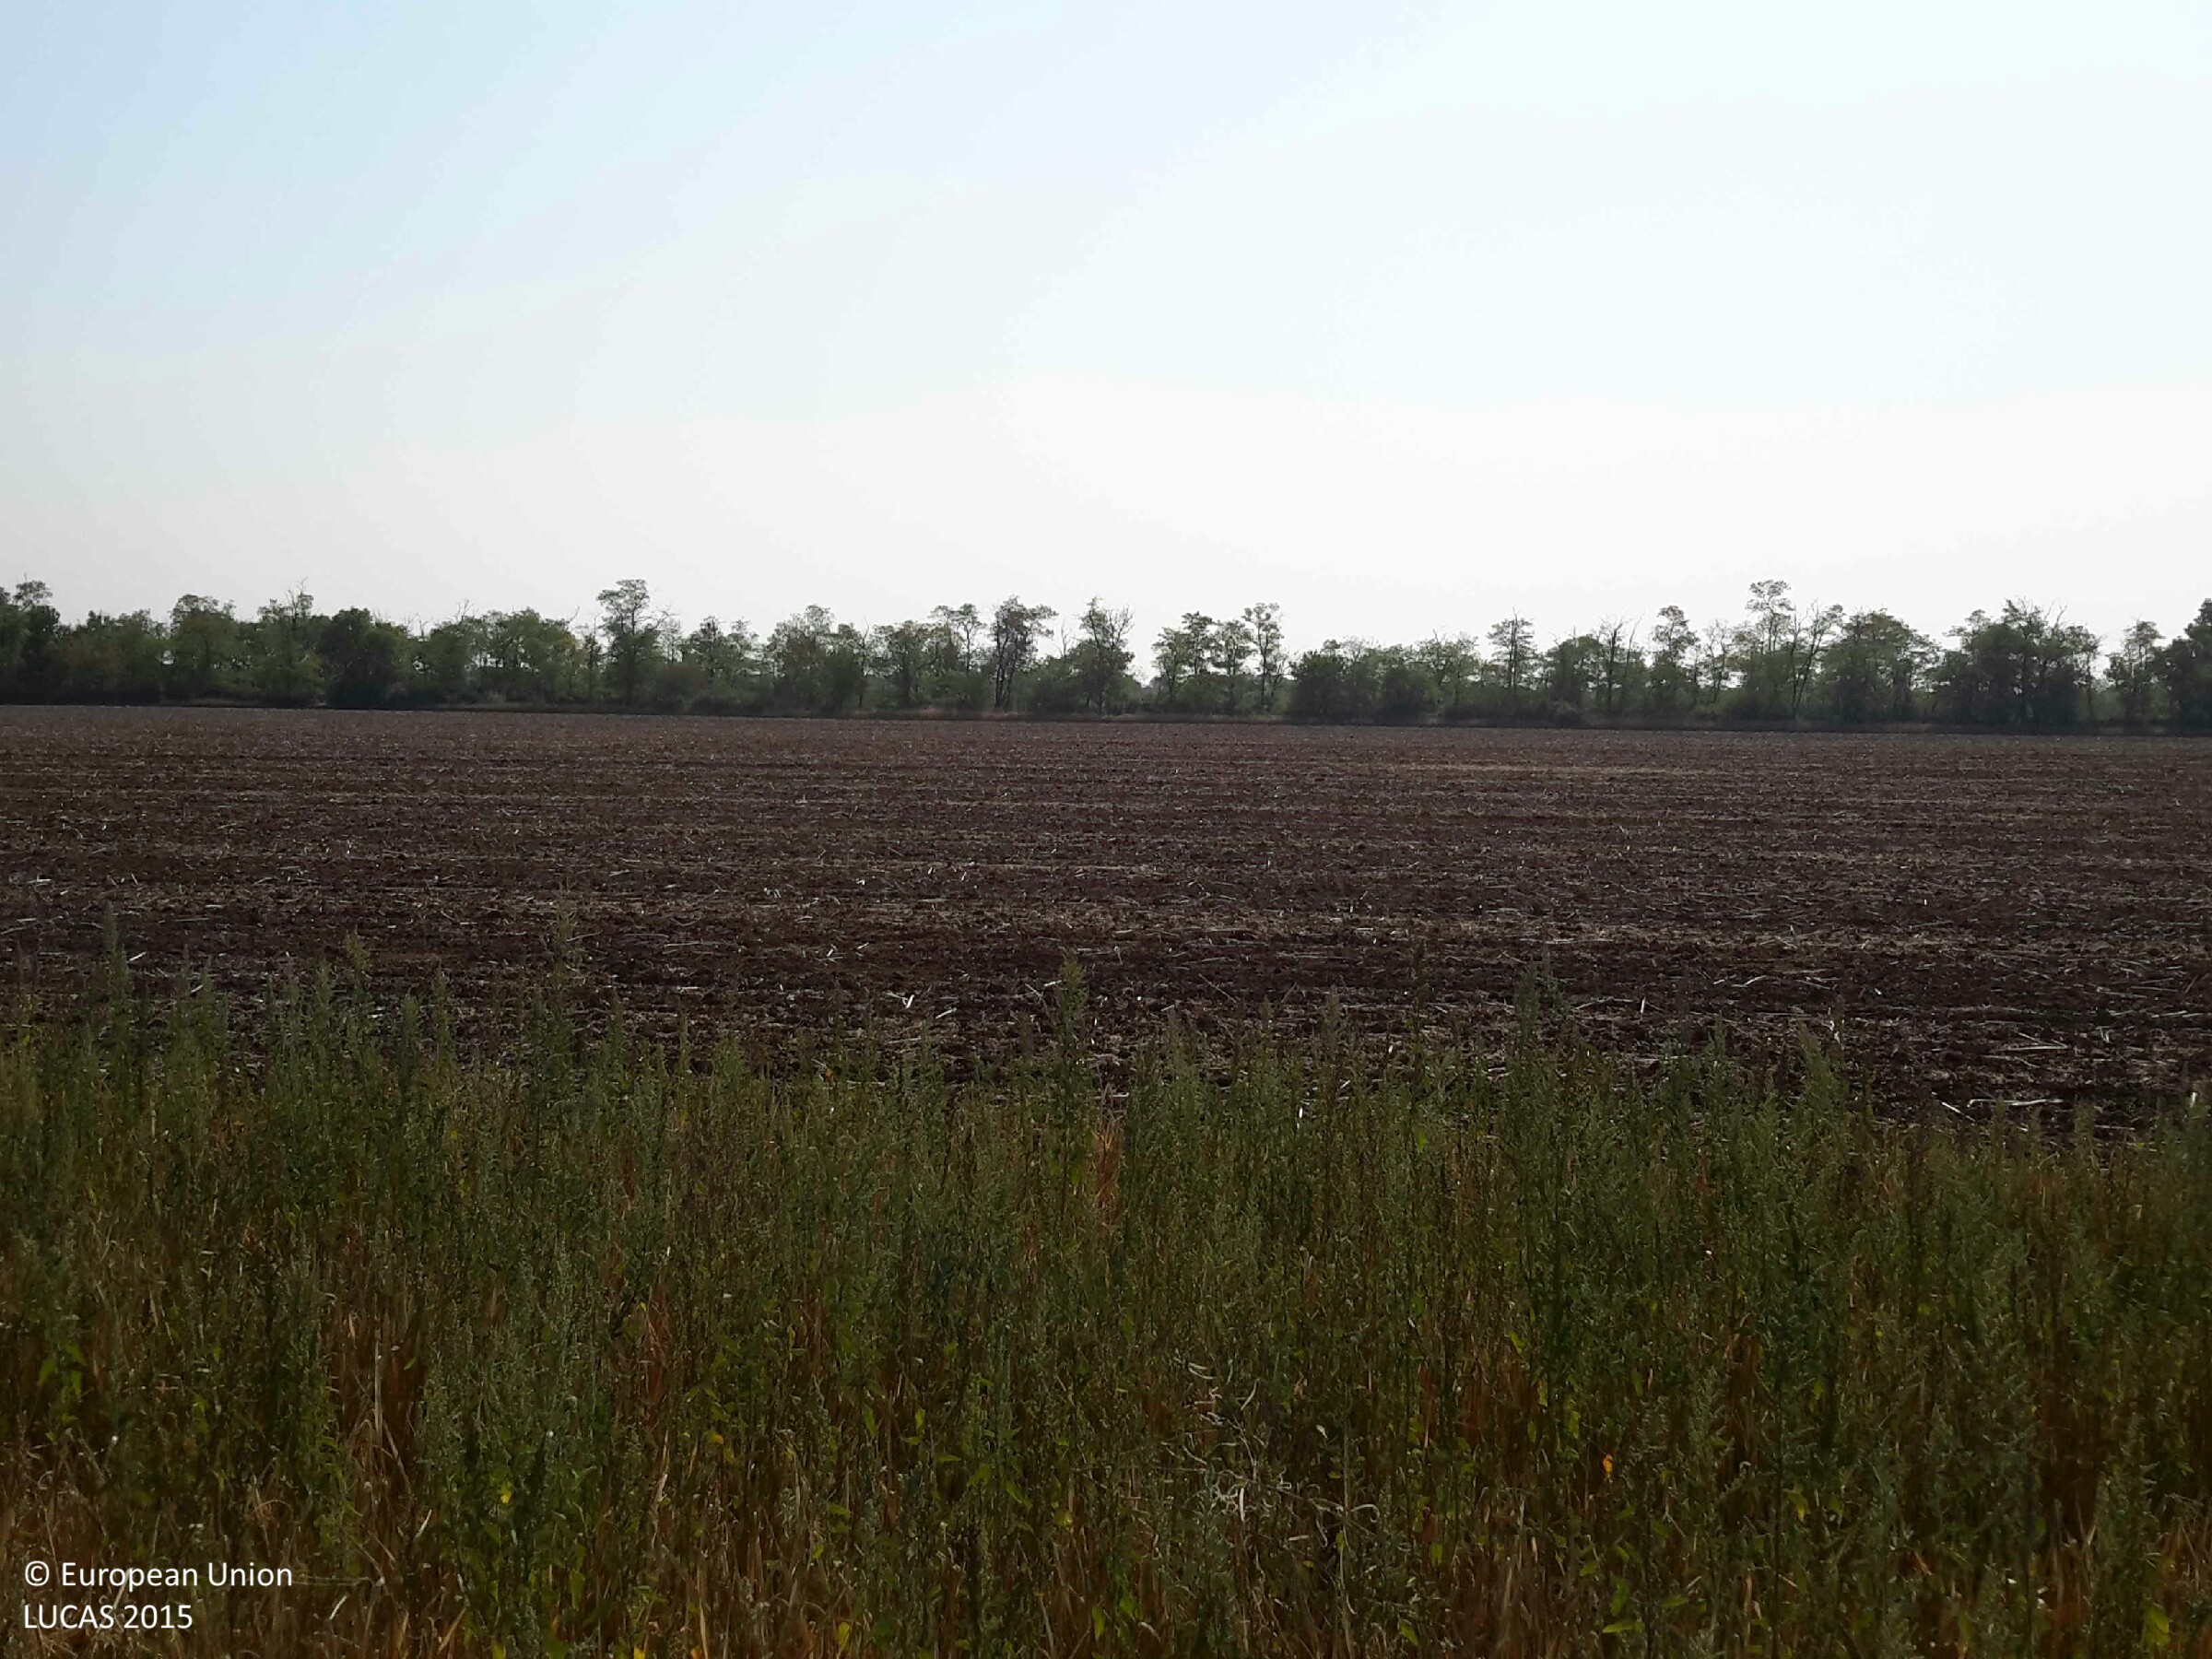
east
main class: Cropland
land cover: Rape and turnip rape
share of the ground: < 10 %
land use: Agriculture (excluding fallow land and kitchen gardens)
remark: Harvested field
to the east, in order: Rape and turnip rape; Common wheat; Rape and turnip rape; Grass margins; Shrubland with sparse tree cover
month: August
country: HU
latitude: 47.8659
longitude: 17.1325
